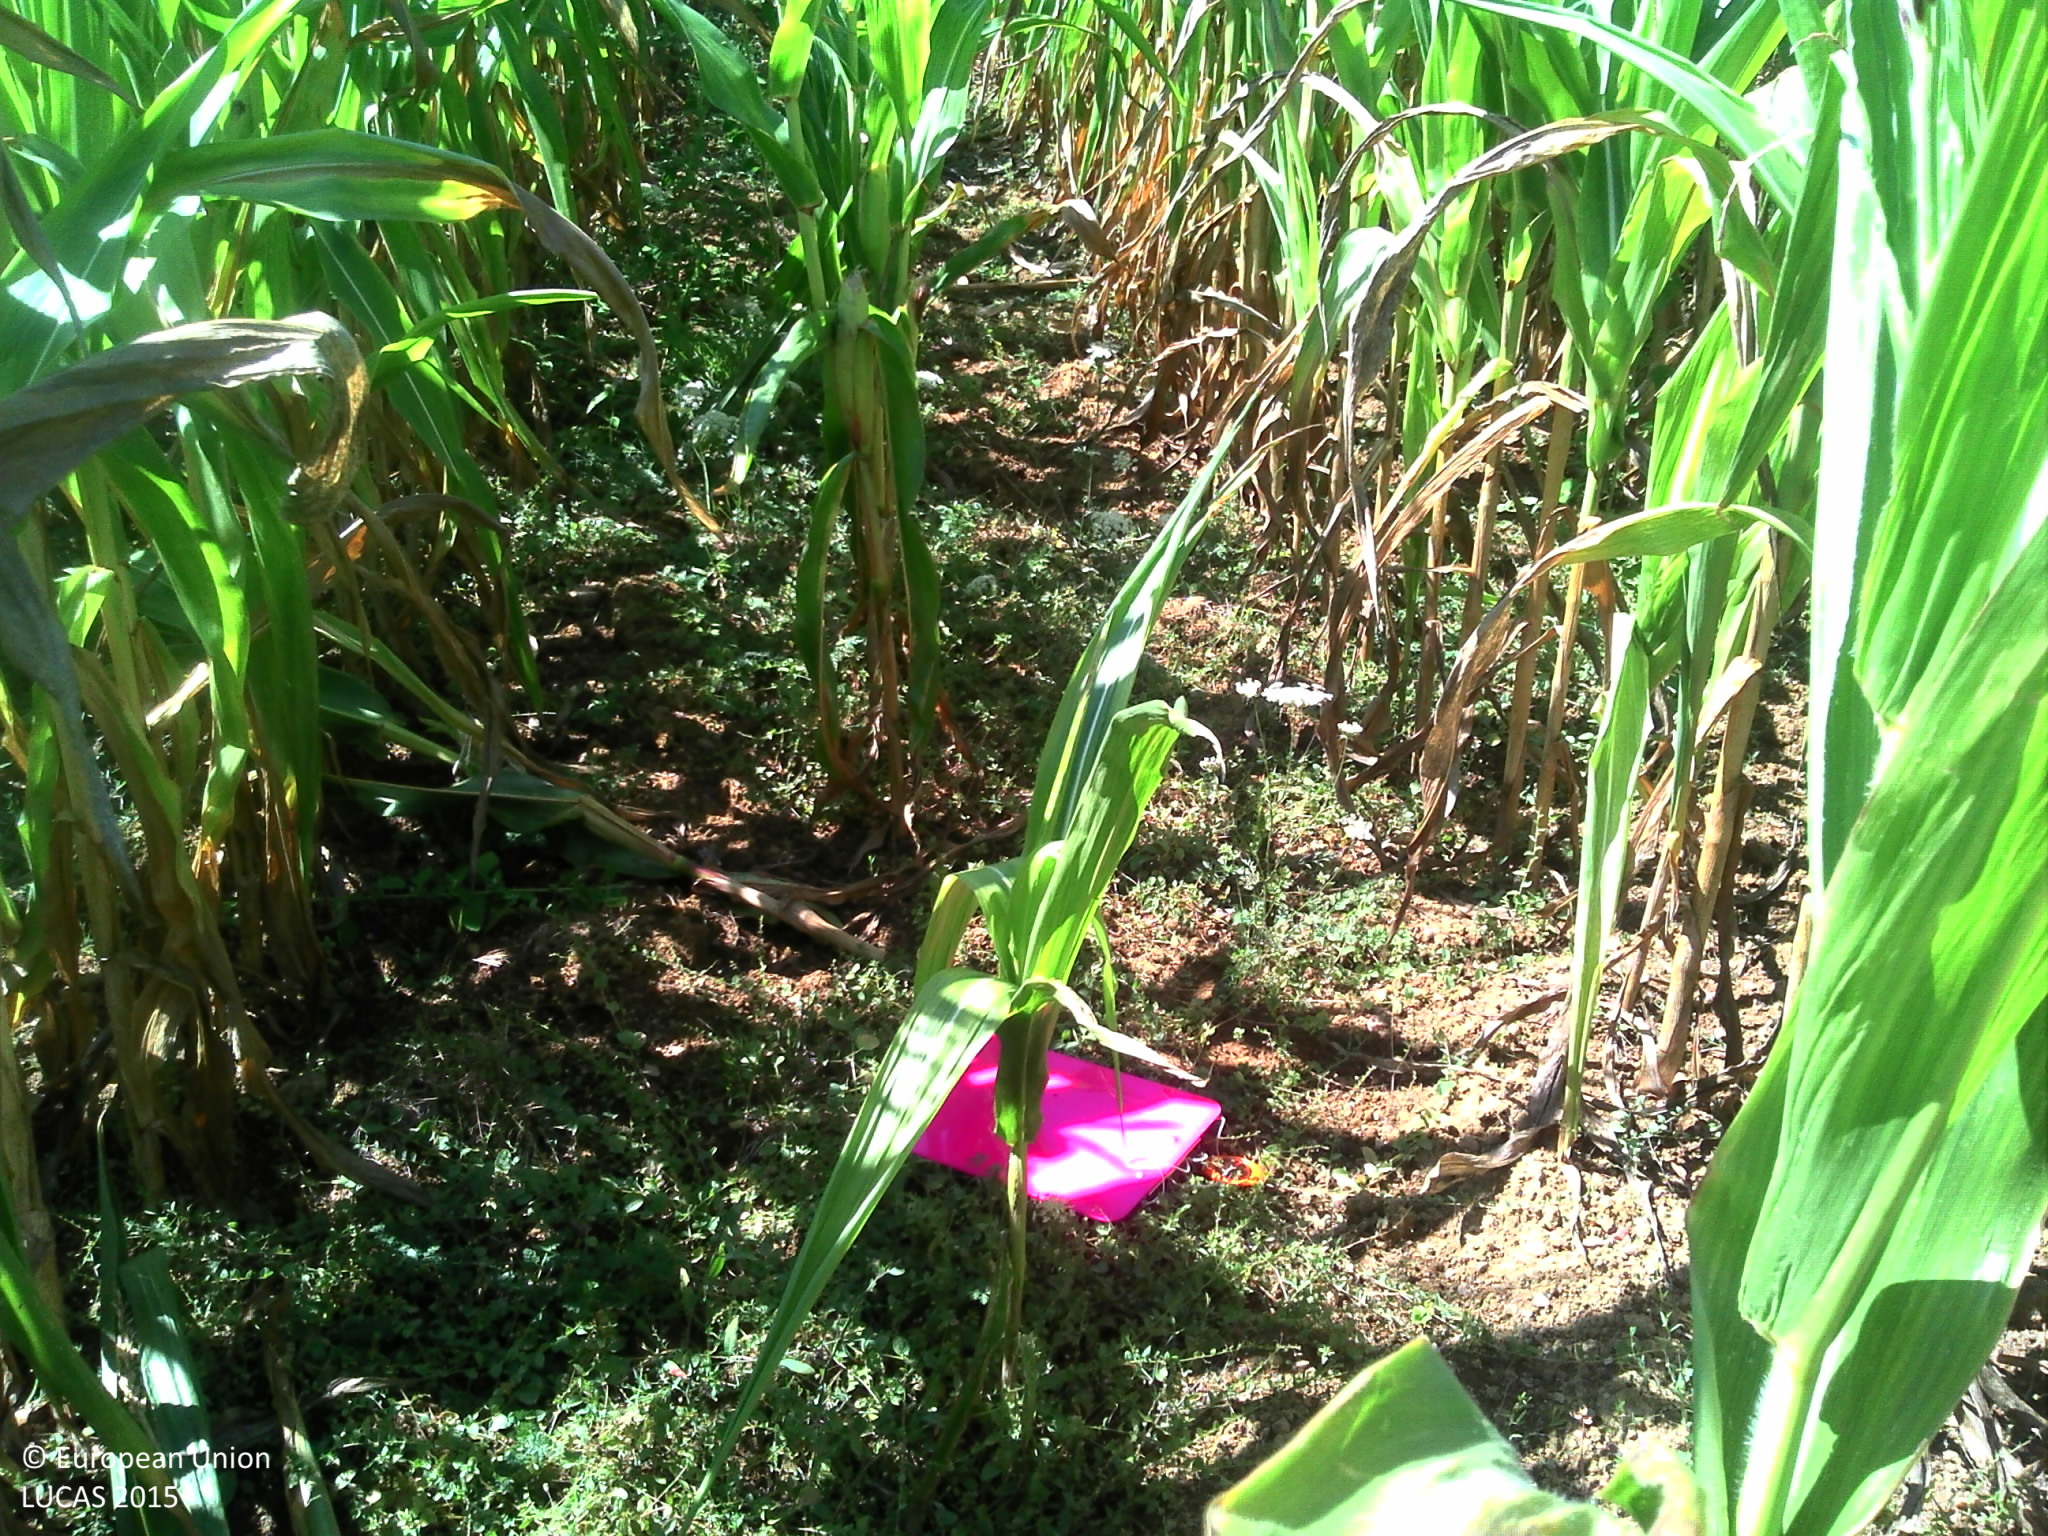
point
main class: Cropland
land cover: Maize
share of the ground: > 75 %
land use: Agriculture (excluding fallow land and kitchen gardens)
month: August
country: FR
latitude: 46.1828
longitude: 0.9315
